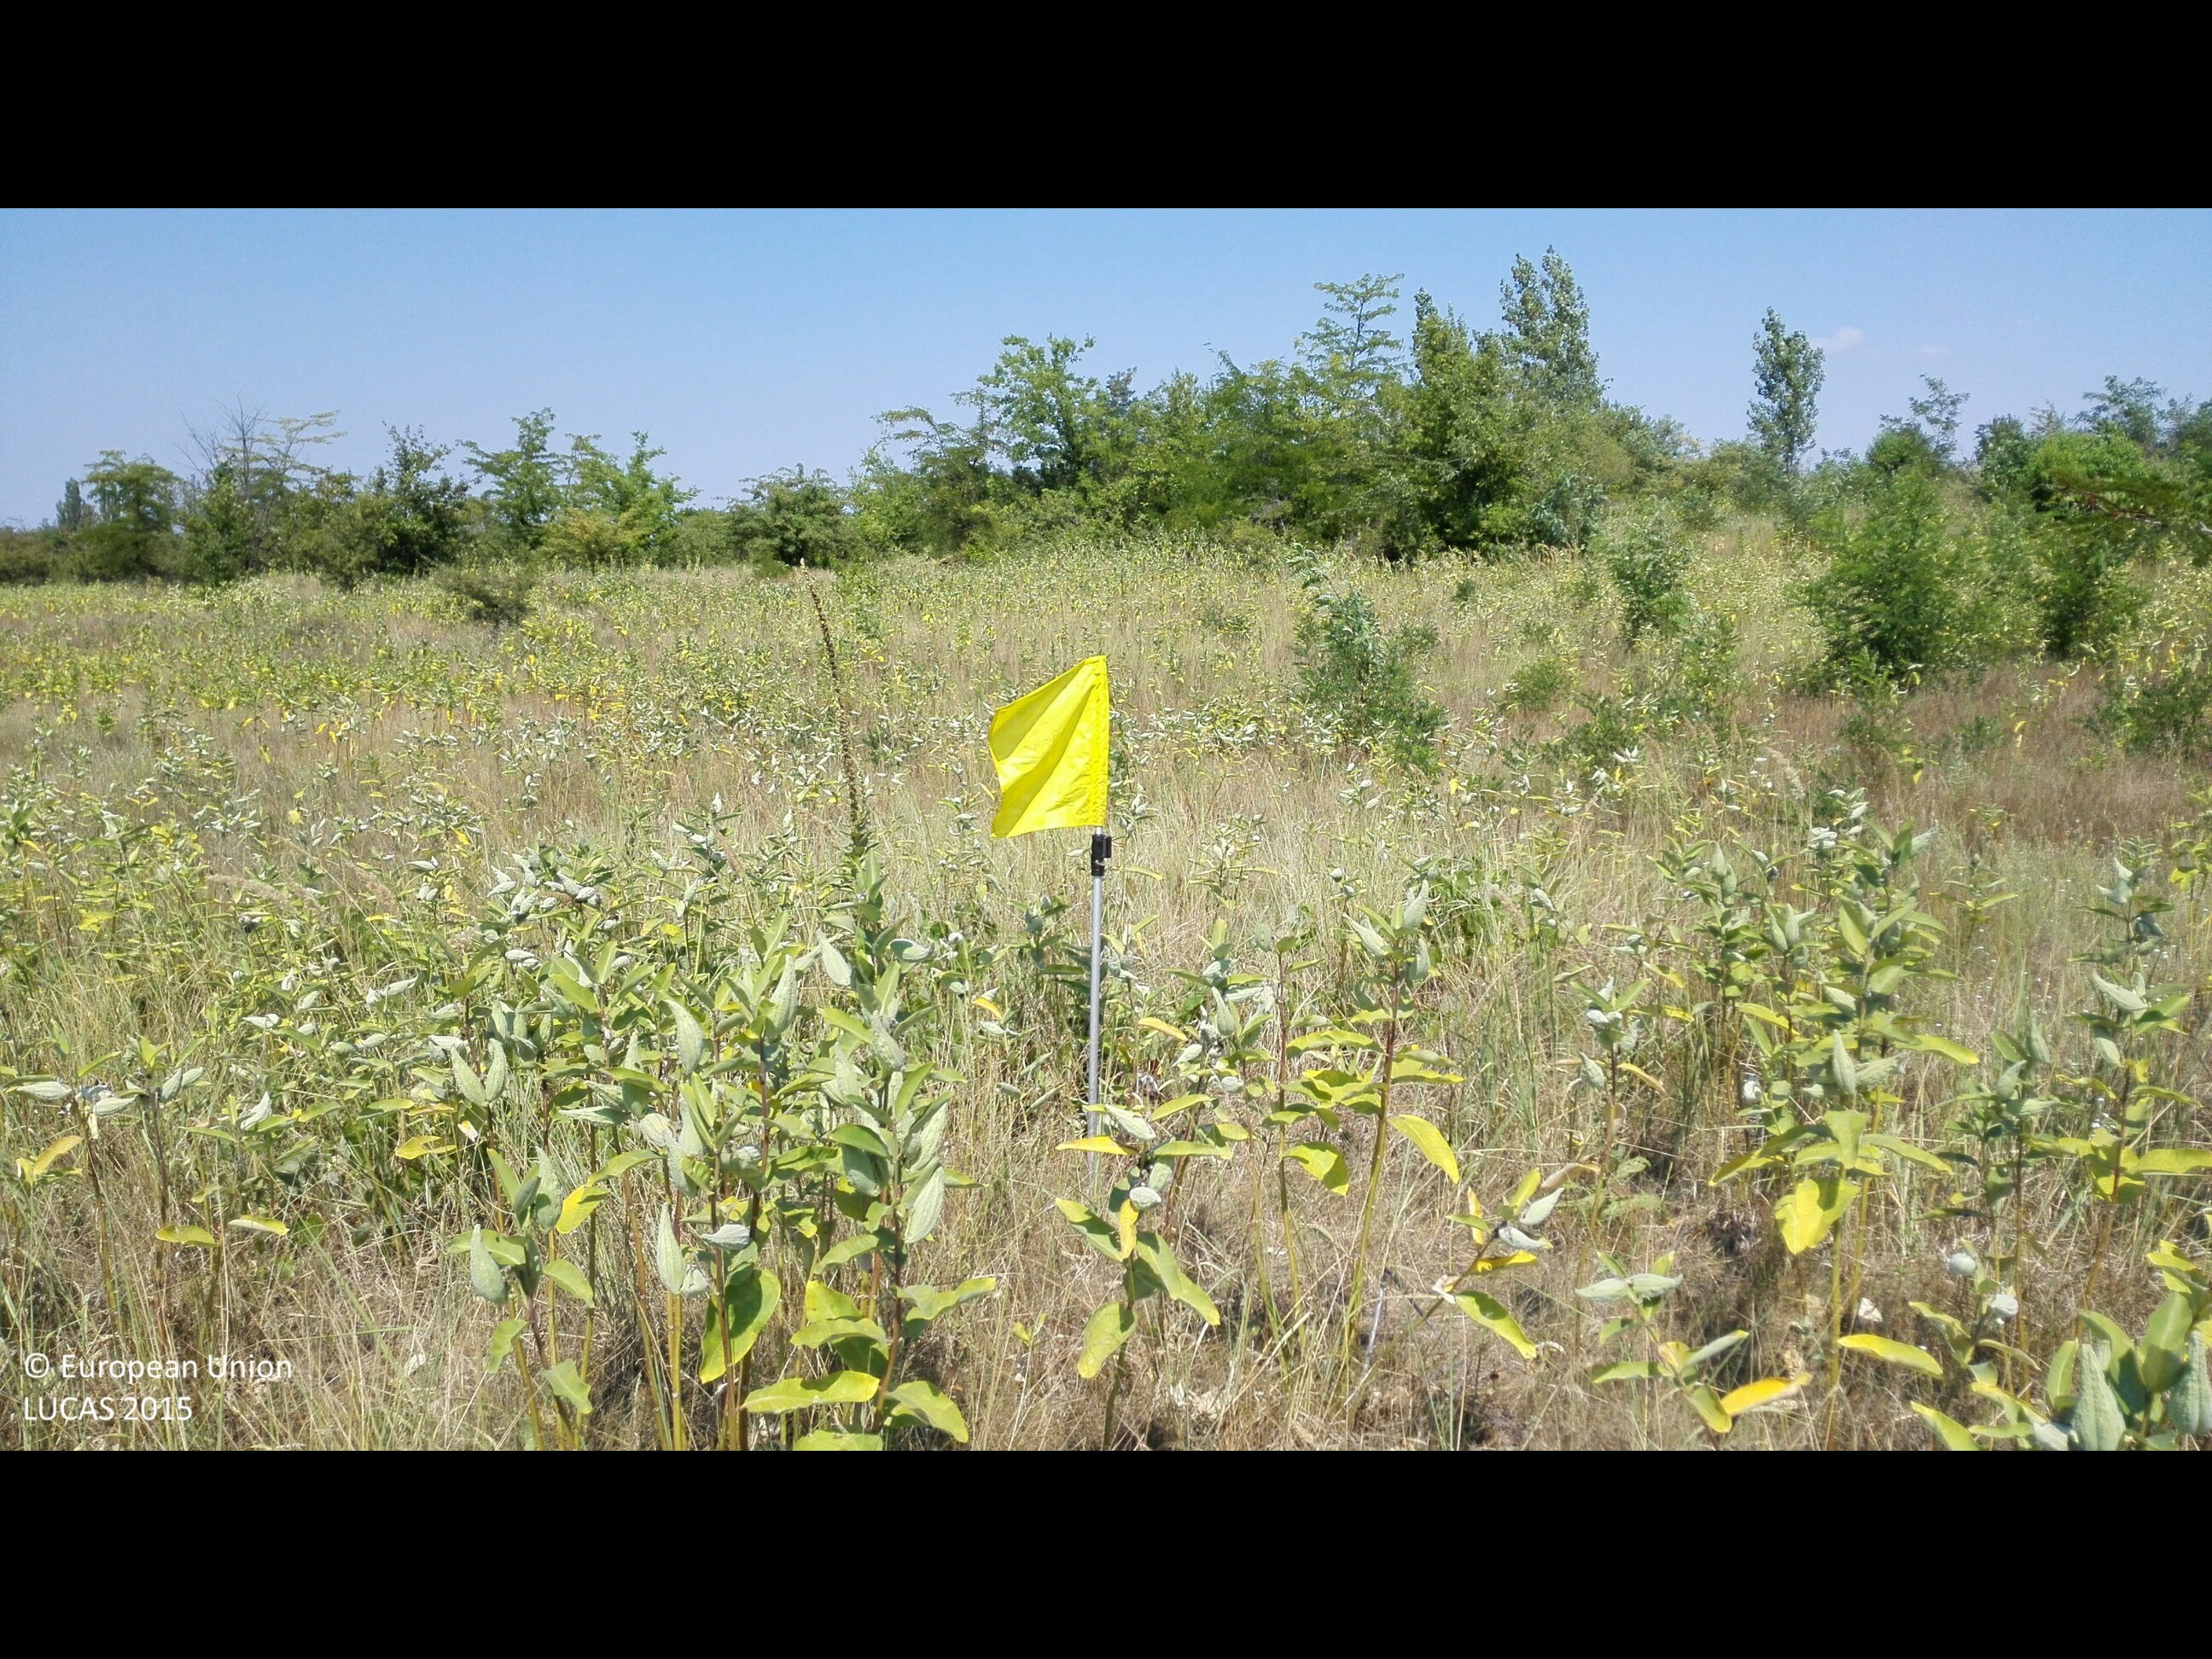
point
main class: Grassland
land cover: Grassland with sparse tree/shrub cover
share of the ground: > 75 %
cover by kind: herbaceous plants 90 %, broadleaved forest trees 5 %, shrubs 5 %
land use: Semi-natural and natural areas not in use
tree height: < 5 m
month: August
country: HU
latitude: 47.4413
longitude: 21.9700
